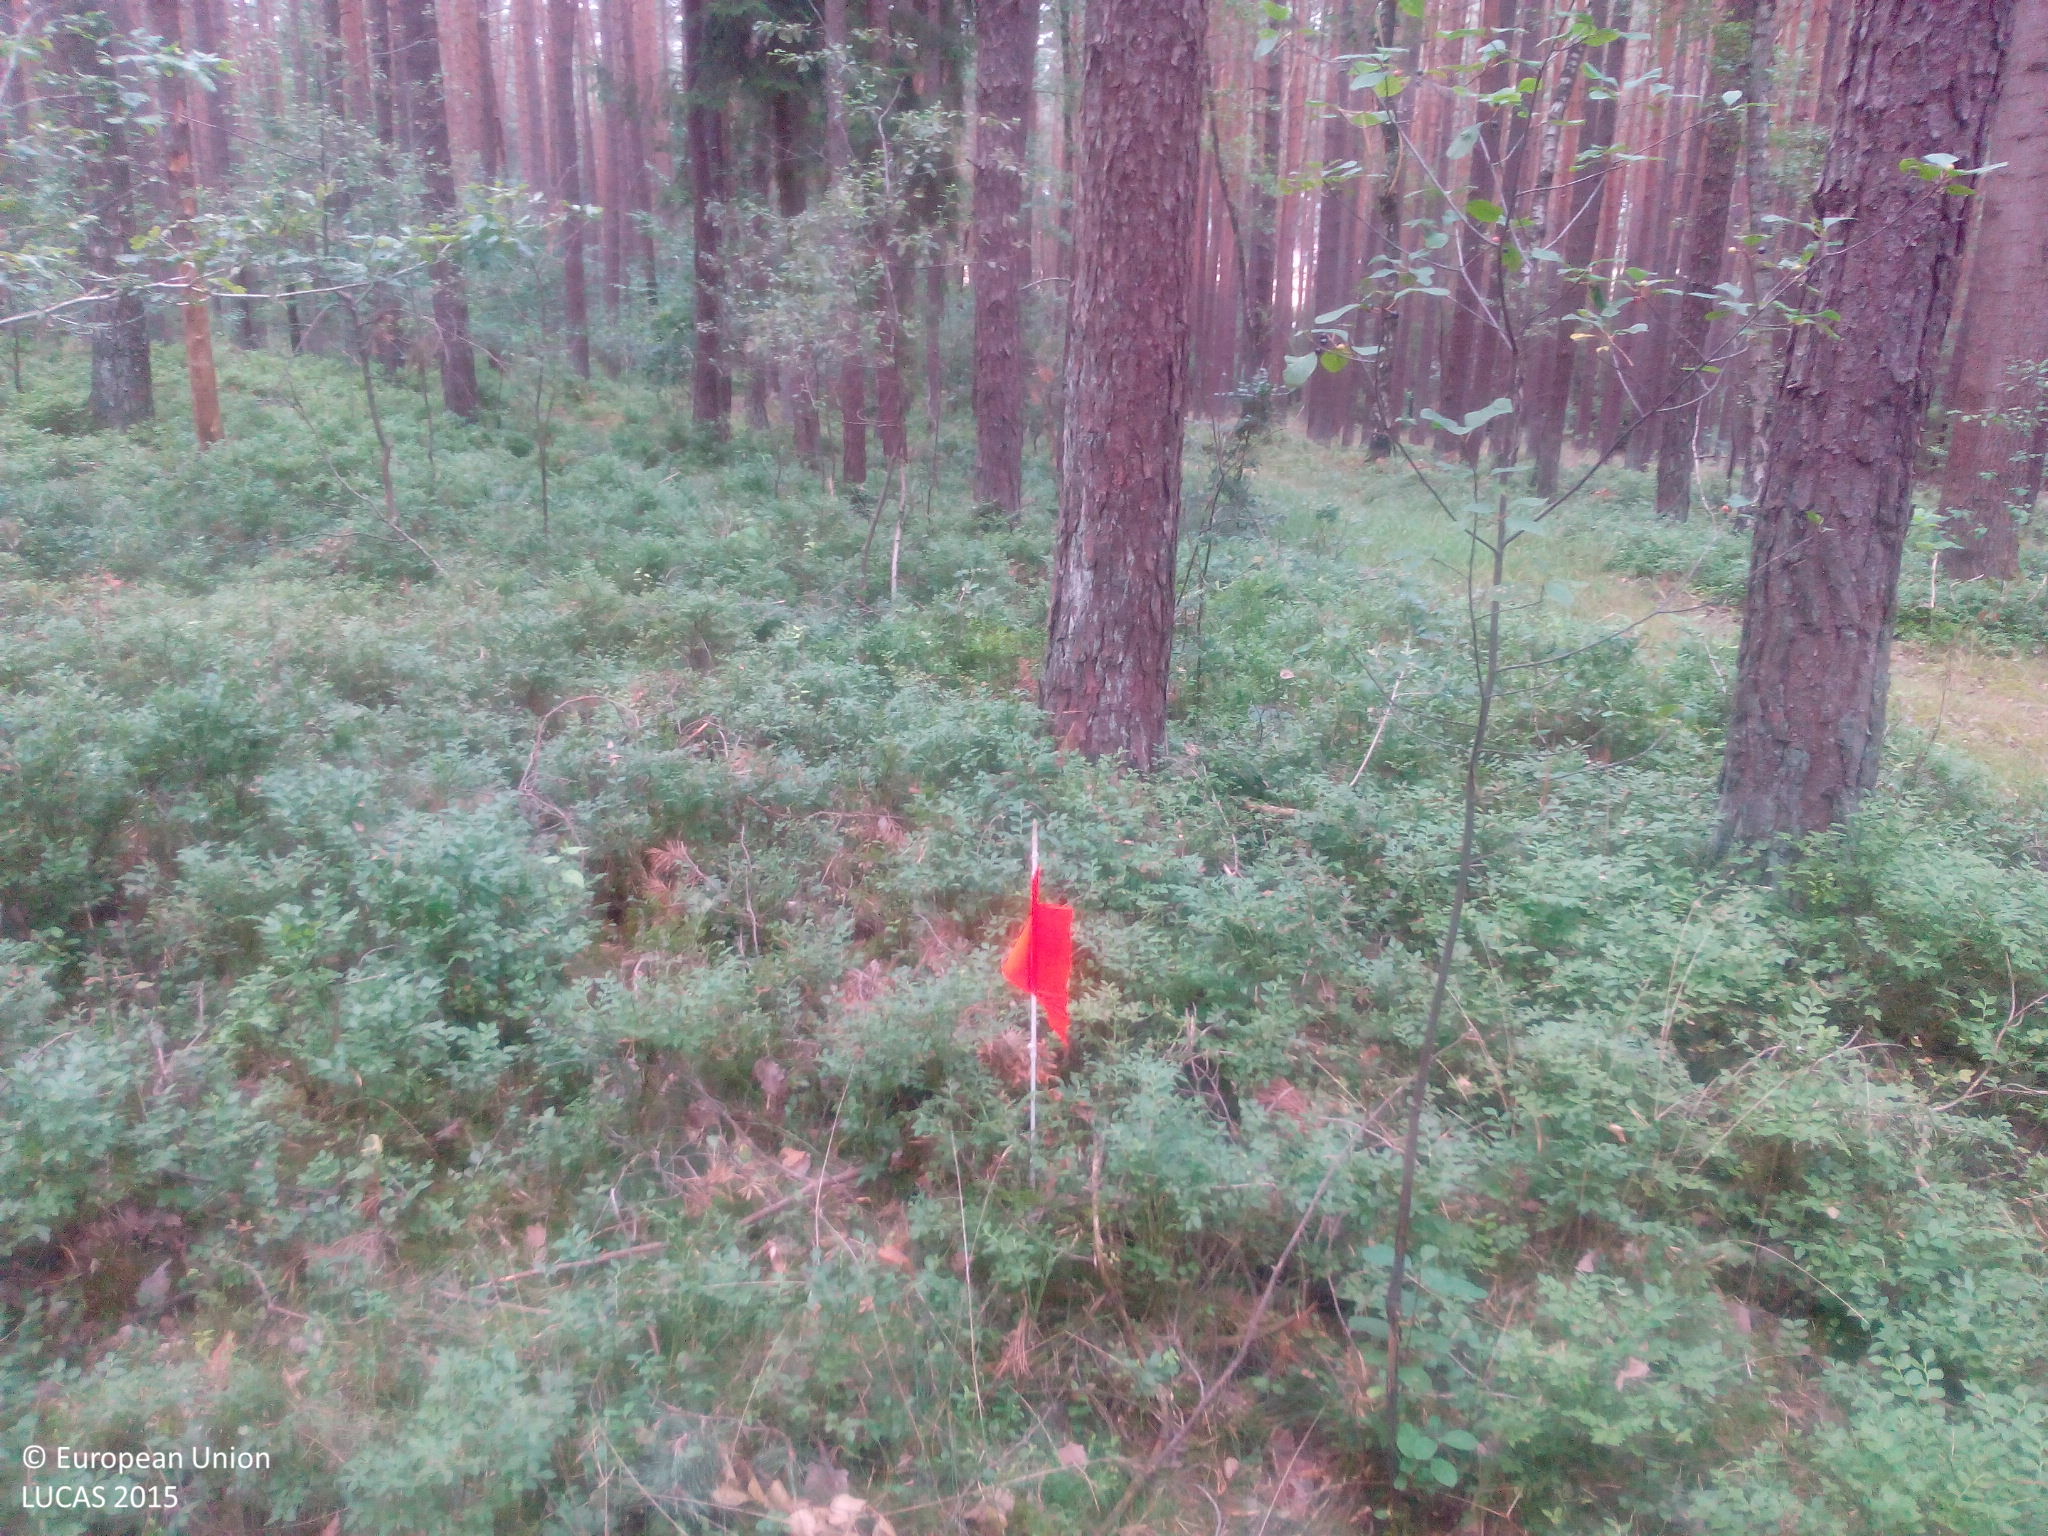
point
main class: Woodland
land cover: Pine dominated coniferous woodland
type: hemiboreal forest and nemoral coniferous forest and mixed broadleaved-coniferous forest
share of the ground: > 75 %
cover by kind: coniferous forest trees 70 %, shrubs 20 %, broadleaved forest trees 10 %
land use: Forestry
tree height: > 5 m
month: July
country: DE
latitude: 49.6052
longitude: 10.8991
